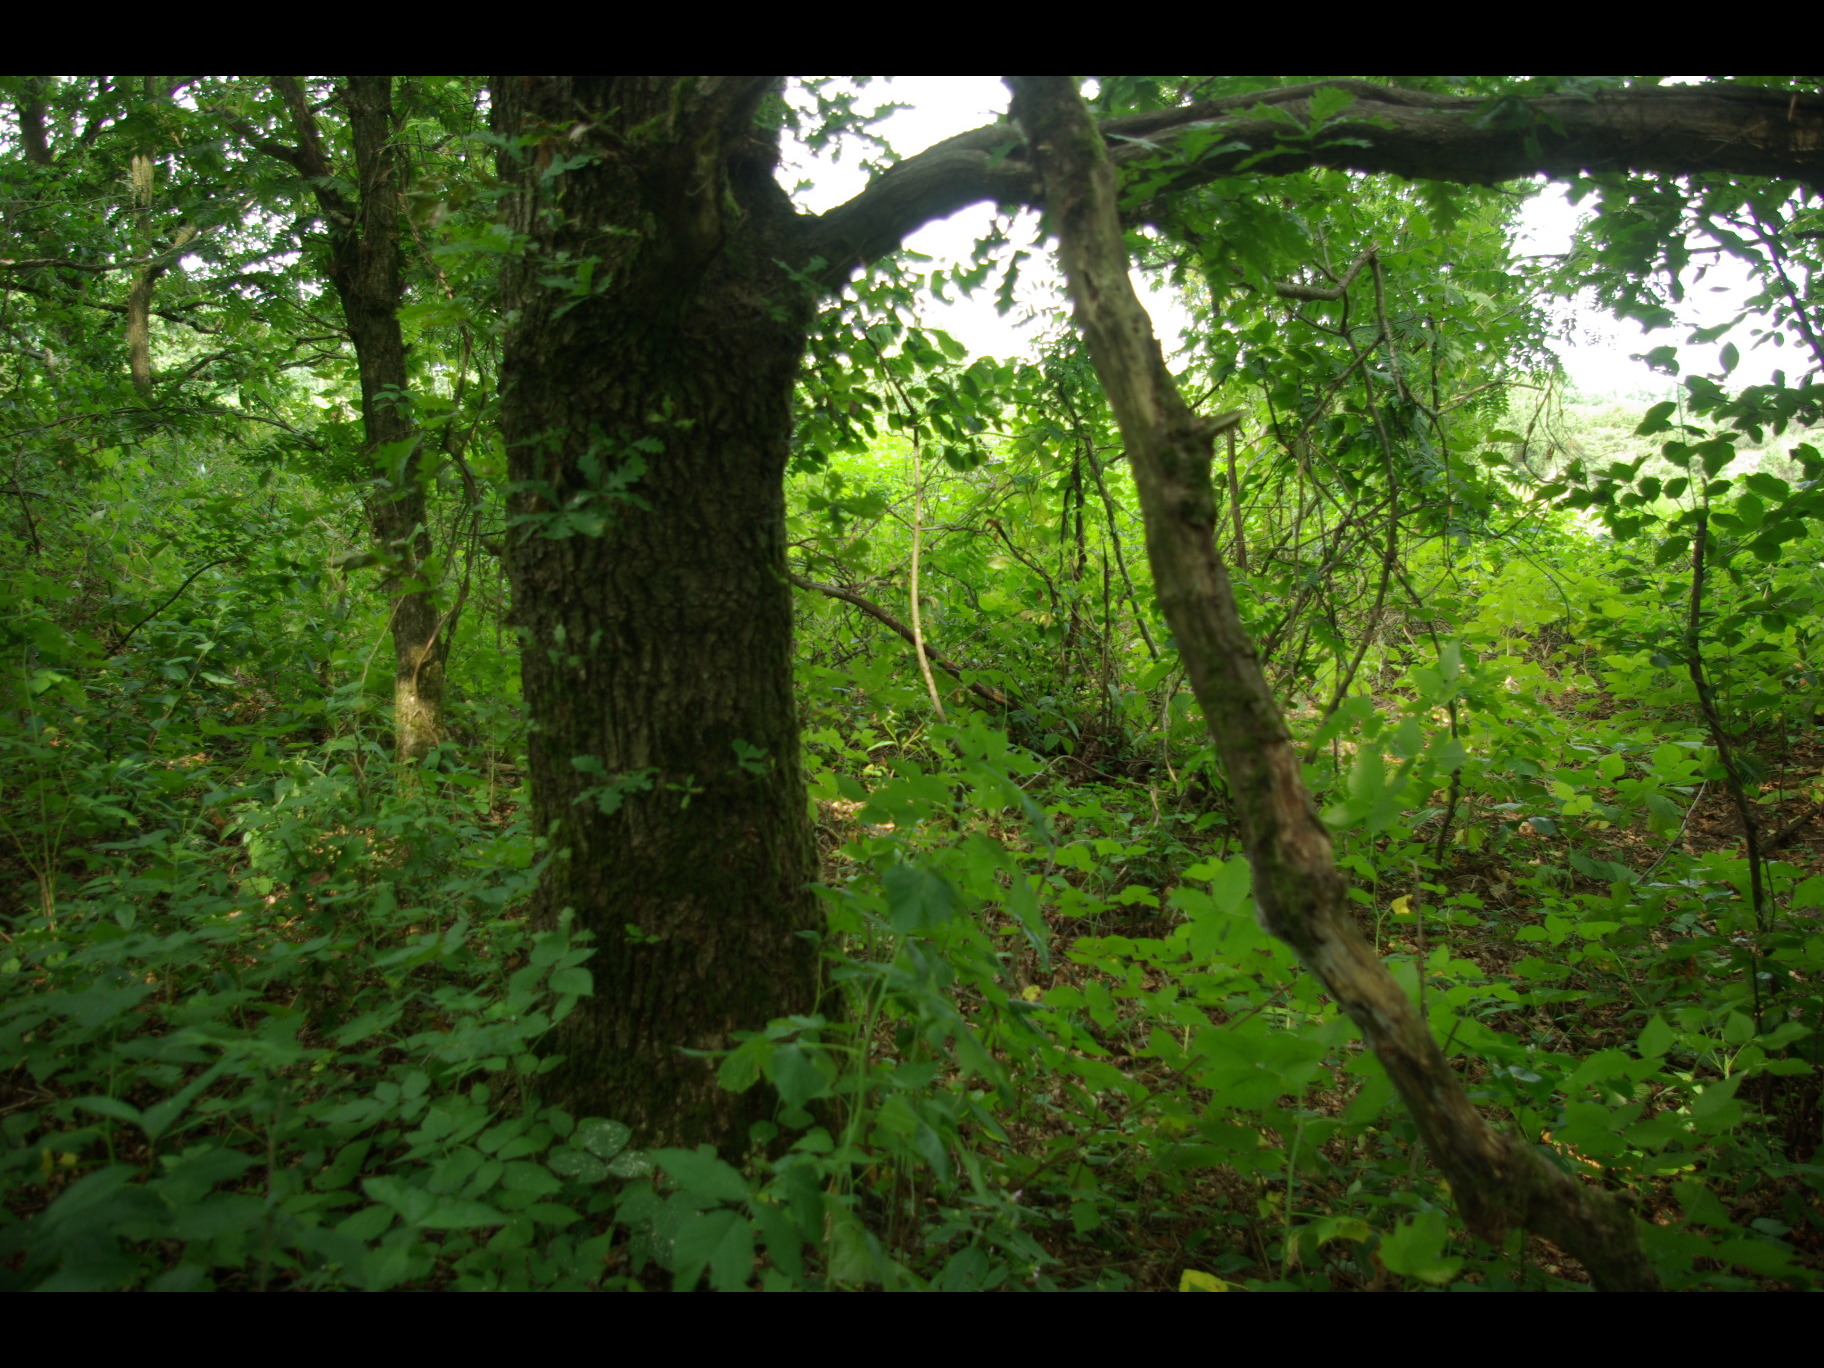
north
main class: Woodland
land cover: Broadleaved woodland
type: mesophytic deciduous forest
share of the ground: > 75 %
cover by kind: broadleaved forest trees 80 %, shrubs 10 %, herbaceous plants 10 %
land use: Semi-natural and natural areas not in use
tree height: > 5 m
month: August
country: DE
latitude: 54.6219
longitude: 9.2726
